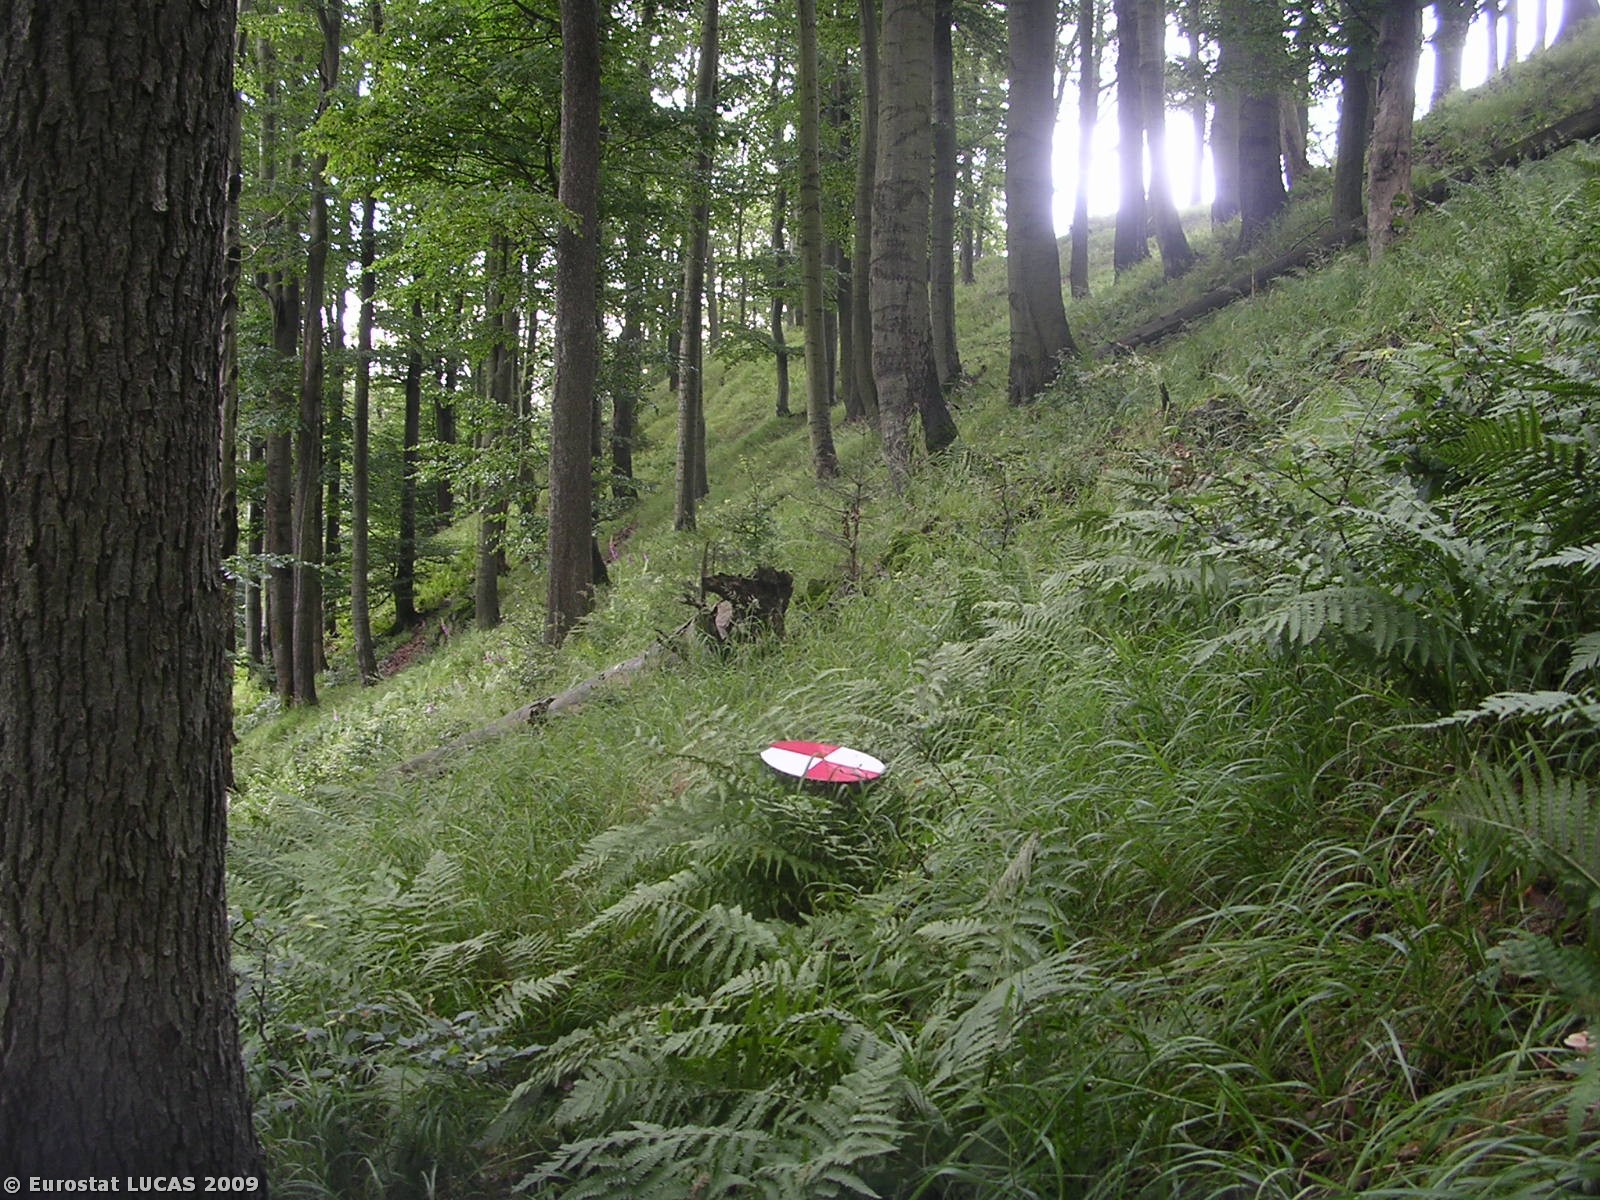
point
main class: Woodland
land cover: Broadleaved woodland
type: mountainous beech forest
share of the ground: > 75 %
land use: Forestry
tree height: > 5 m
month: July
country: CZ
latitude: 50.7956
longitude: 14.5561
